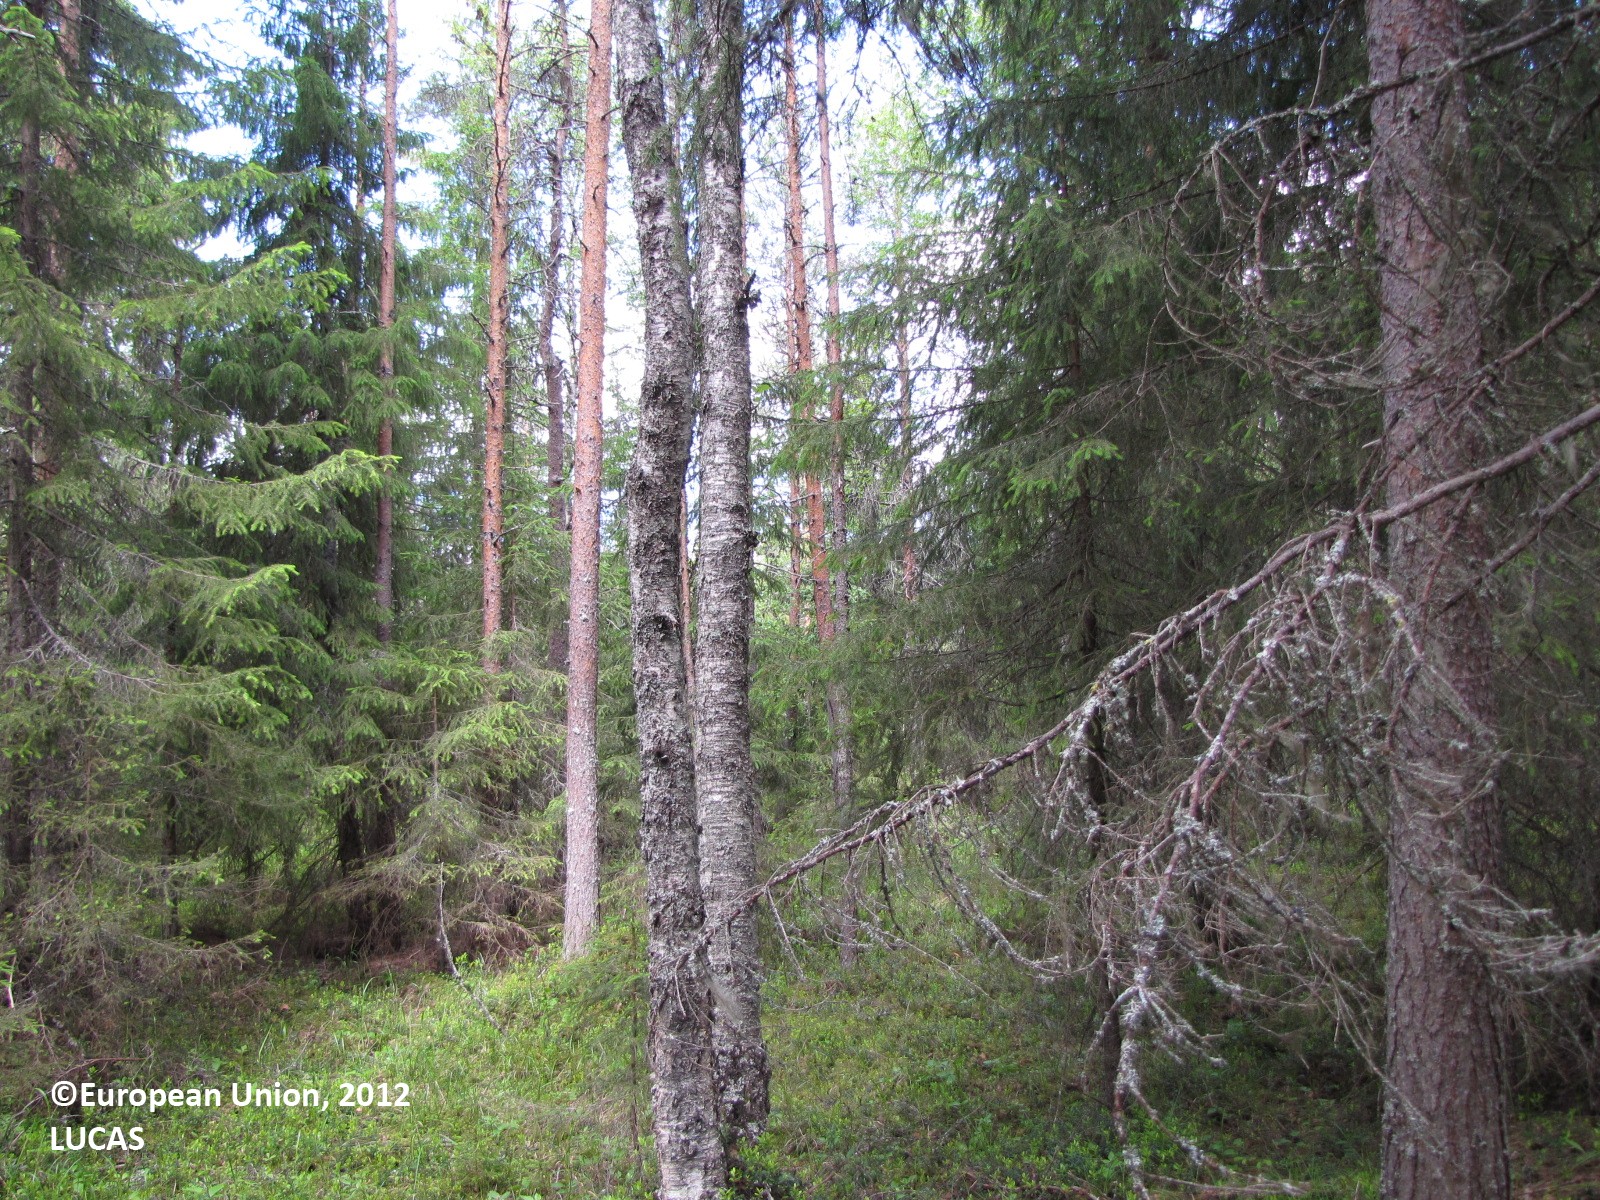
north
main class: Woodland
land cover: Spruce dominated coniferous woodland
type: boreal forest
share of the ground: 50 - 75 %
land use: Forestry
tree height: > 5 m
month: July
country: FI
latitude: 66.2377
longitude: 25.1164
